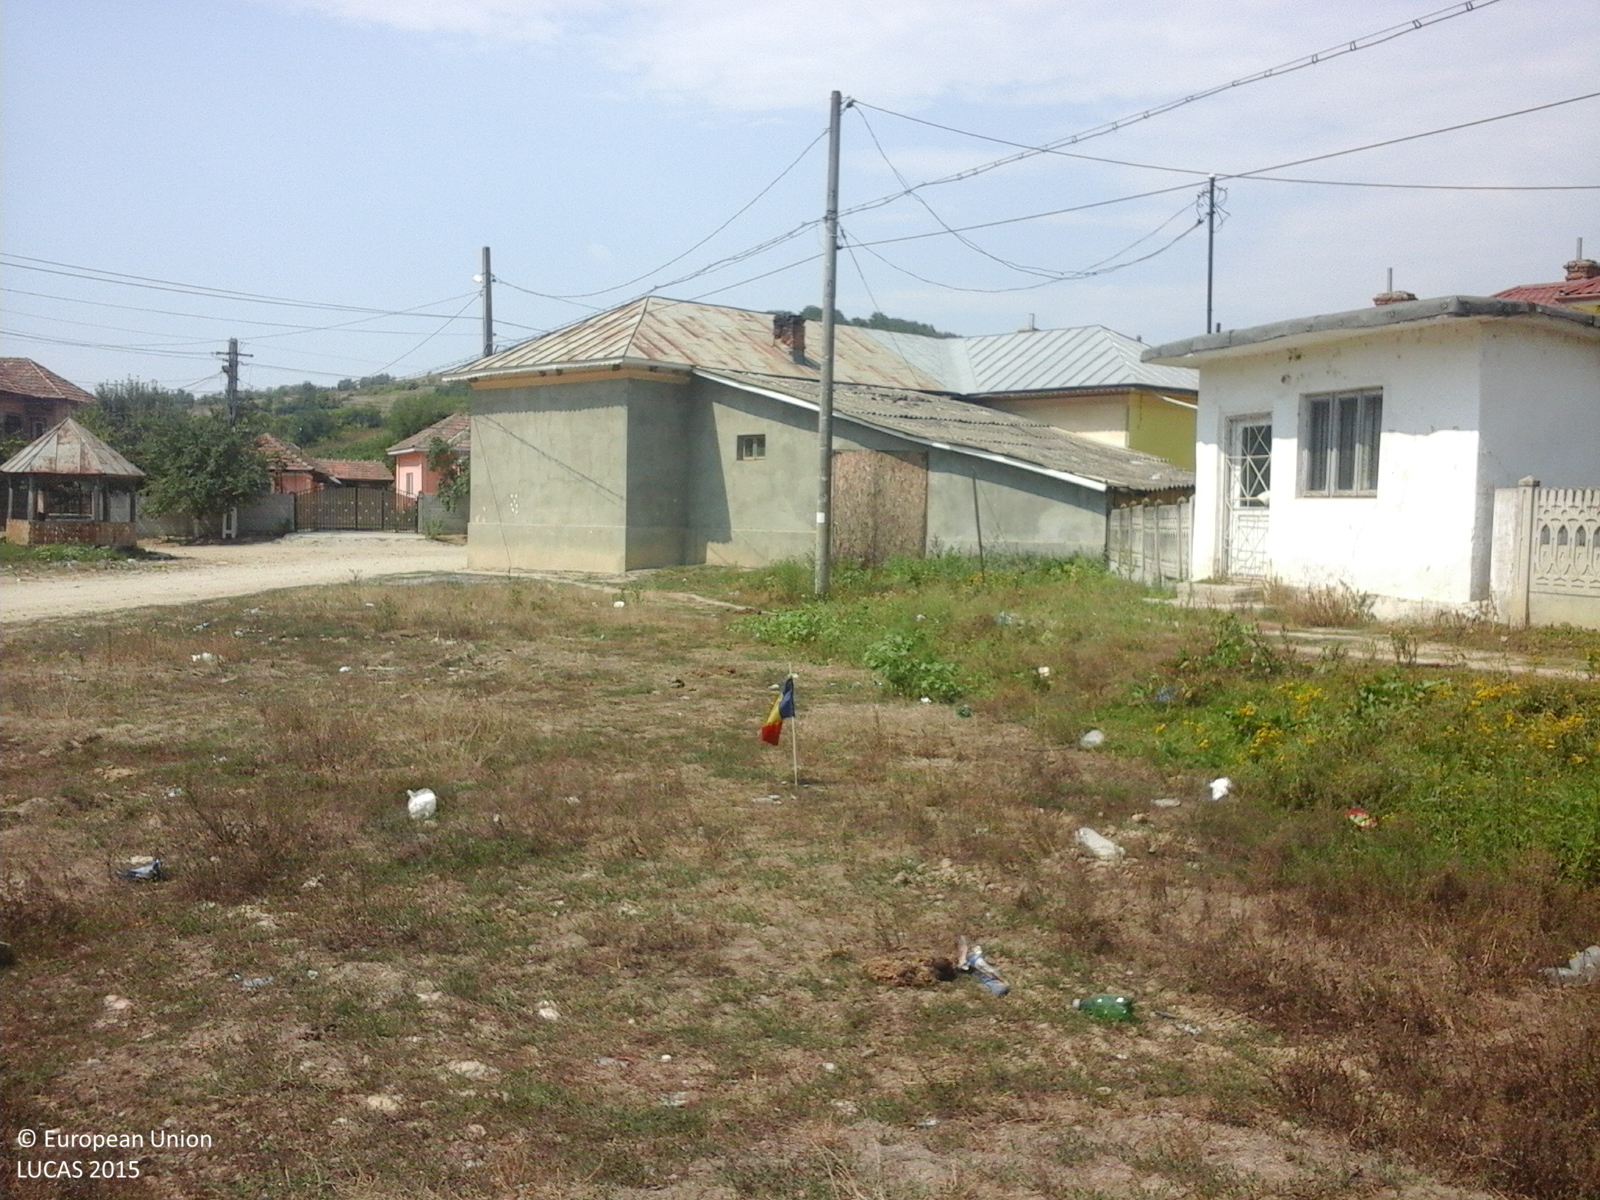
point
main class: Grassland
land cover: Spontaneously vegetated surfaces
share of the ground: > 75 %
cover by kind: herbaceous plants 100 %
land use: Residential
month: August
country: RO
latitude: 44.5869
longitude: 23.5704
